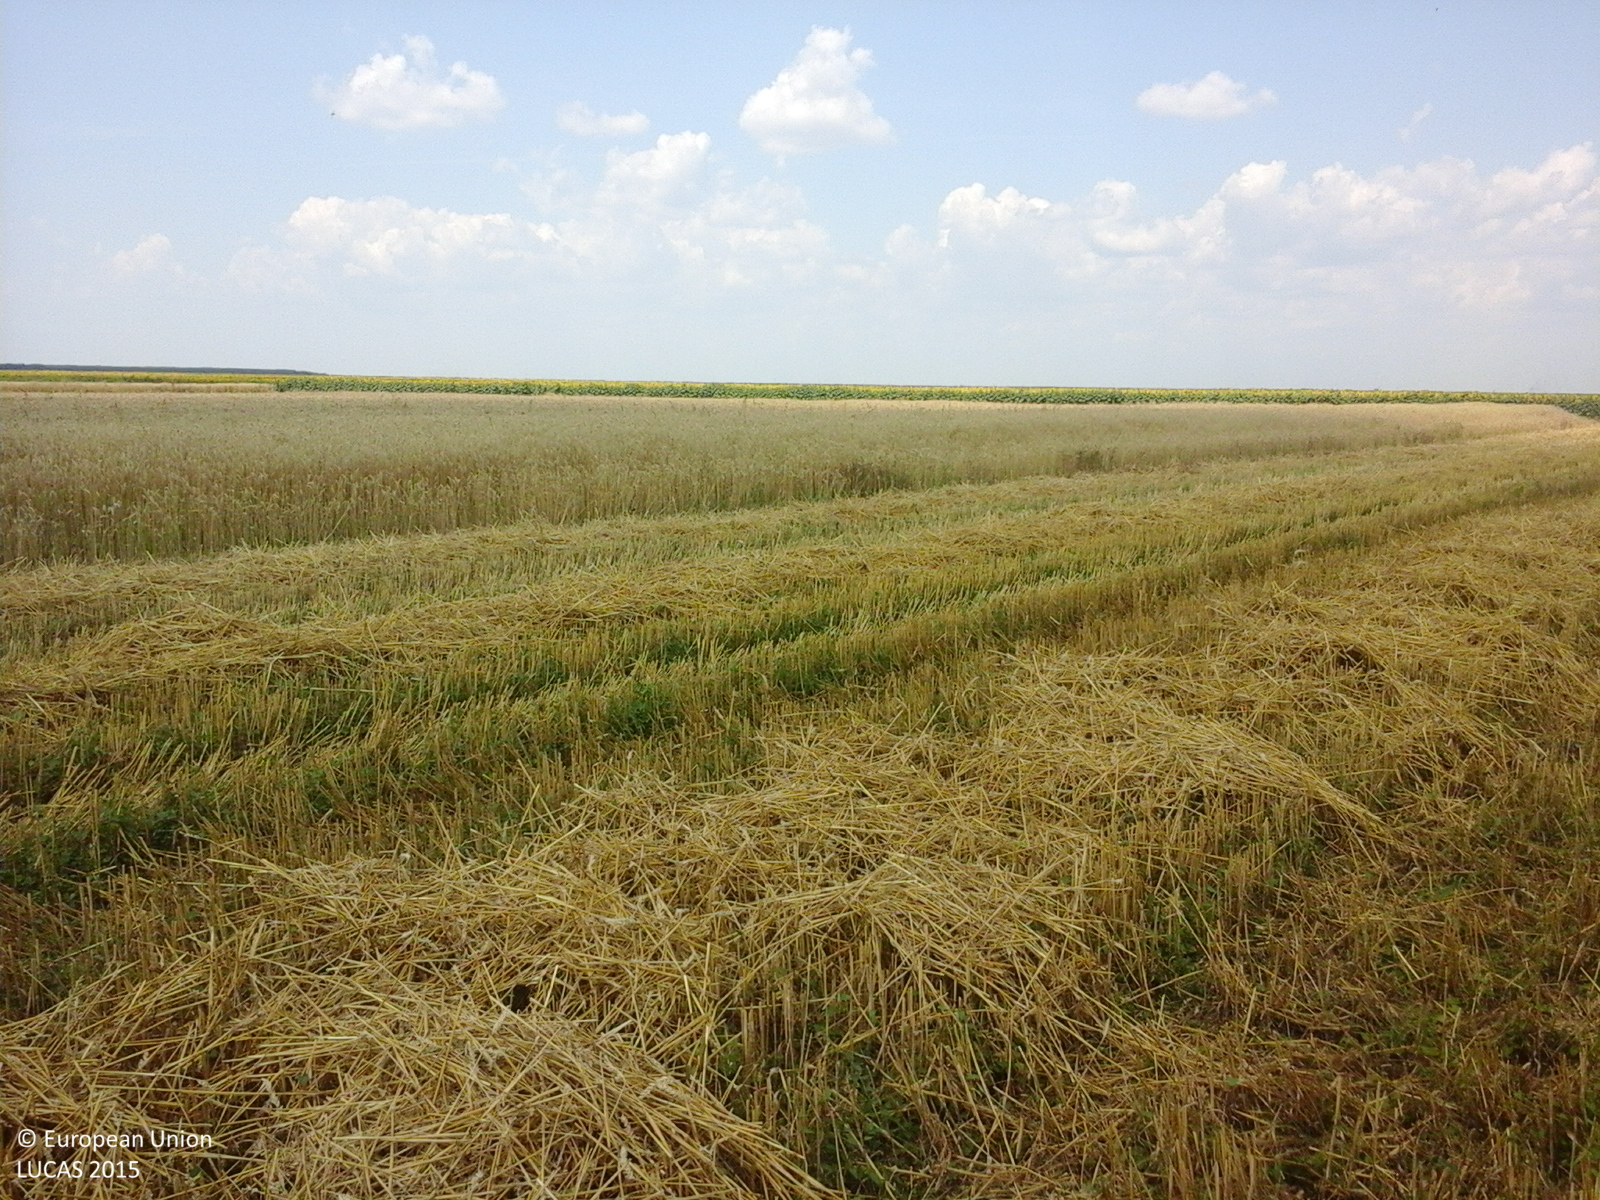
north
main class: Cropland
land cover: Common wheat
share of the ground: < 10 %
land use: Agriculture (excluding fallow land and kitchen gardens)
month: July
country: RO
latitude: 43.9640
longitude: 25.1471
